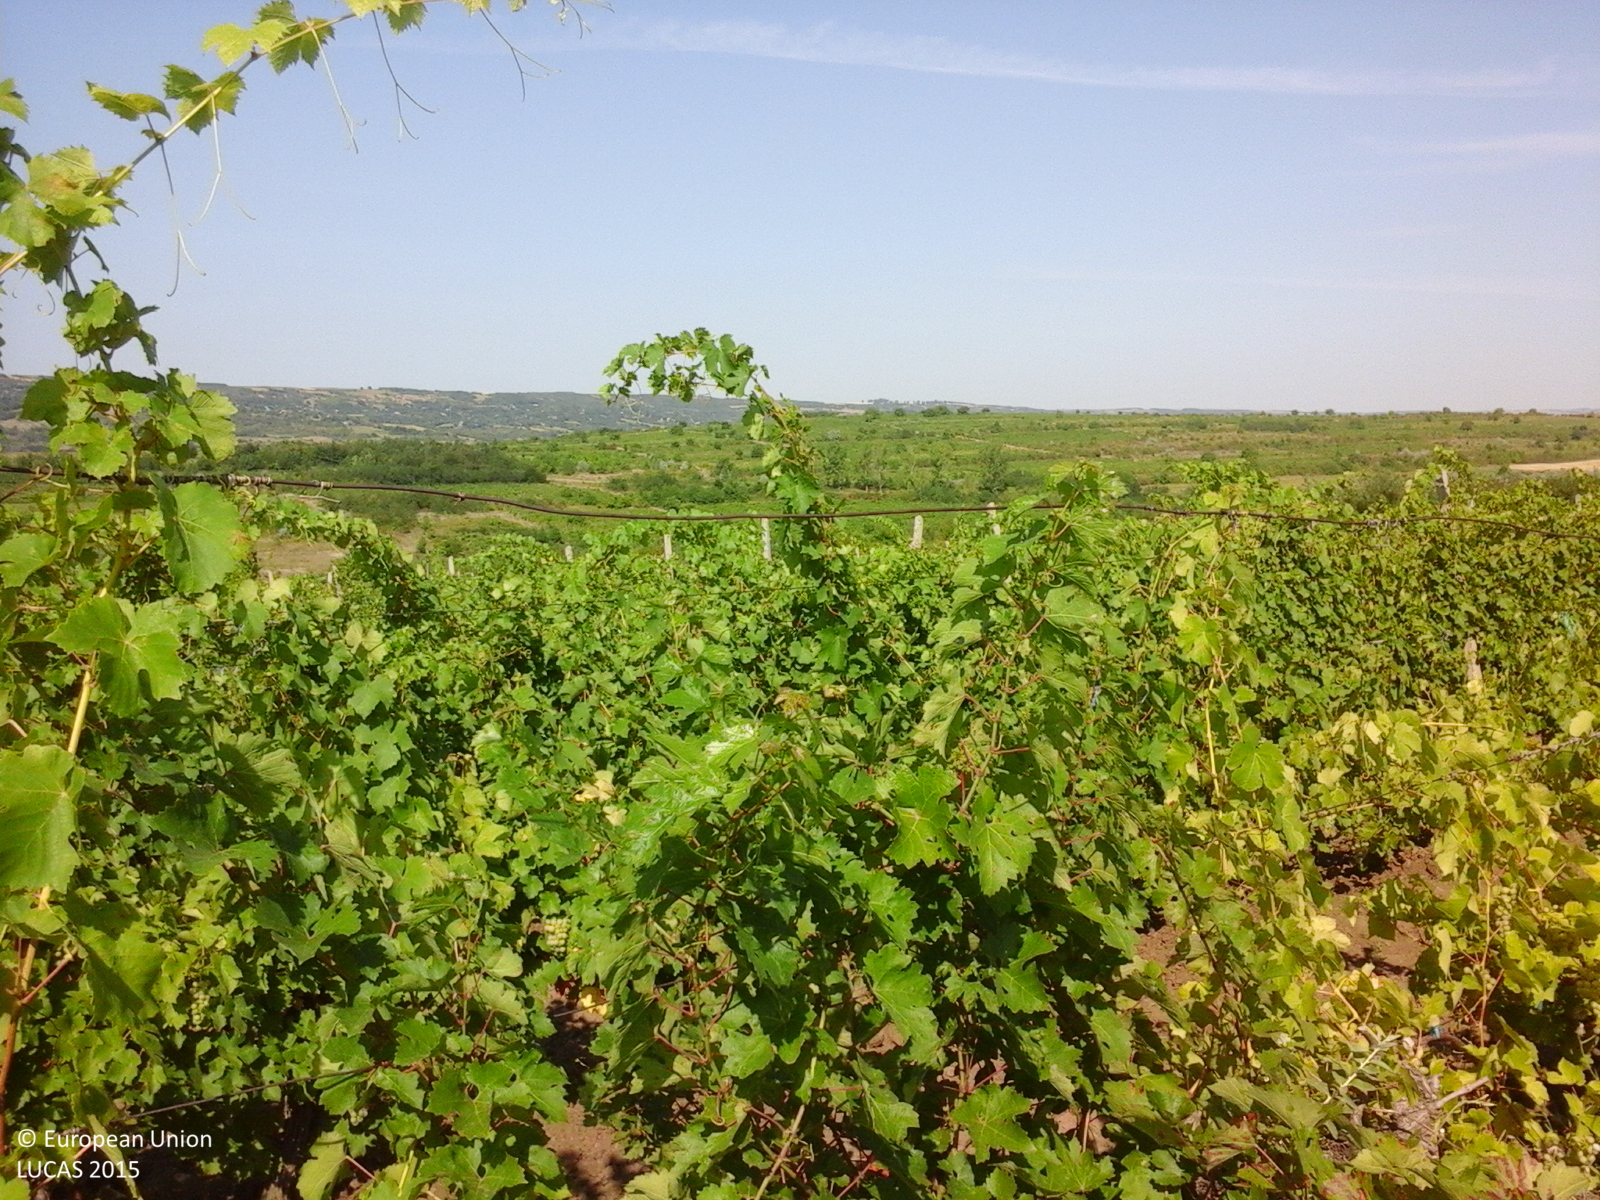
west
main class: Cropland
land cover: Vineyards
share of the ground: 50 - 75 %
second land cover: Other bare soil
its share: > 75 %
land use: Agriculture (excluding fallow land and kitchen gardens)
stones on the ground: < 10 %
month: July
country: RO
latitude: 46.0963
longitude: 28.0124
